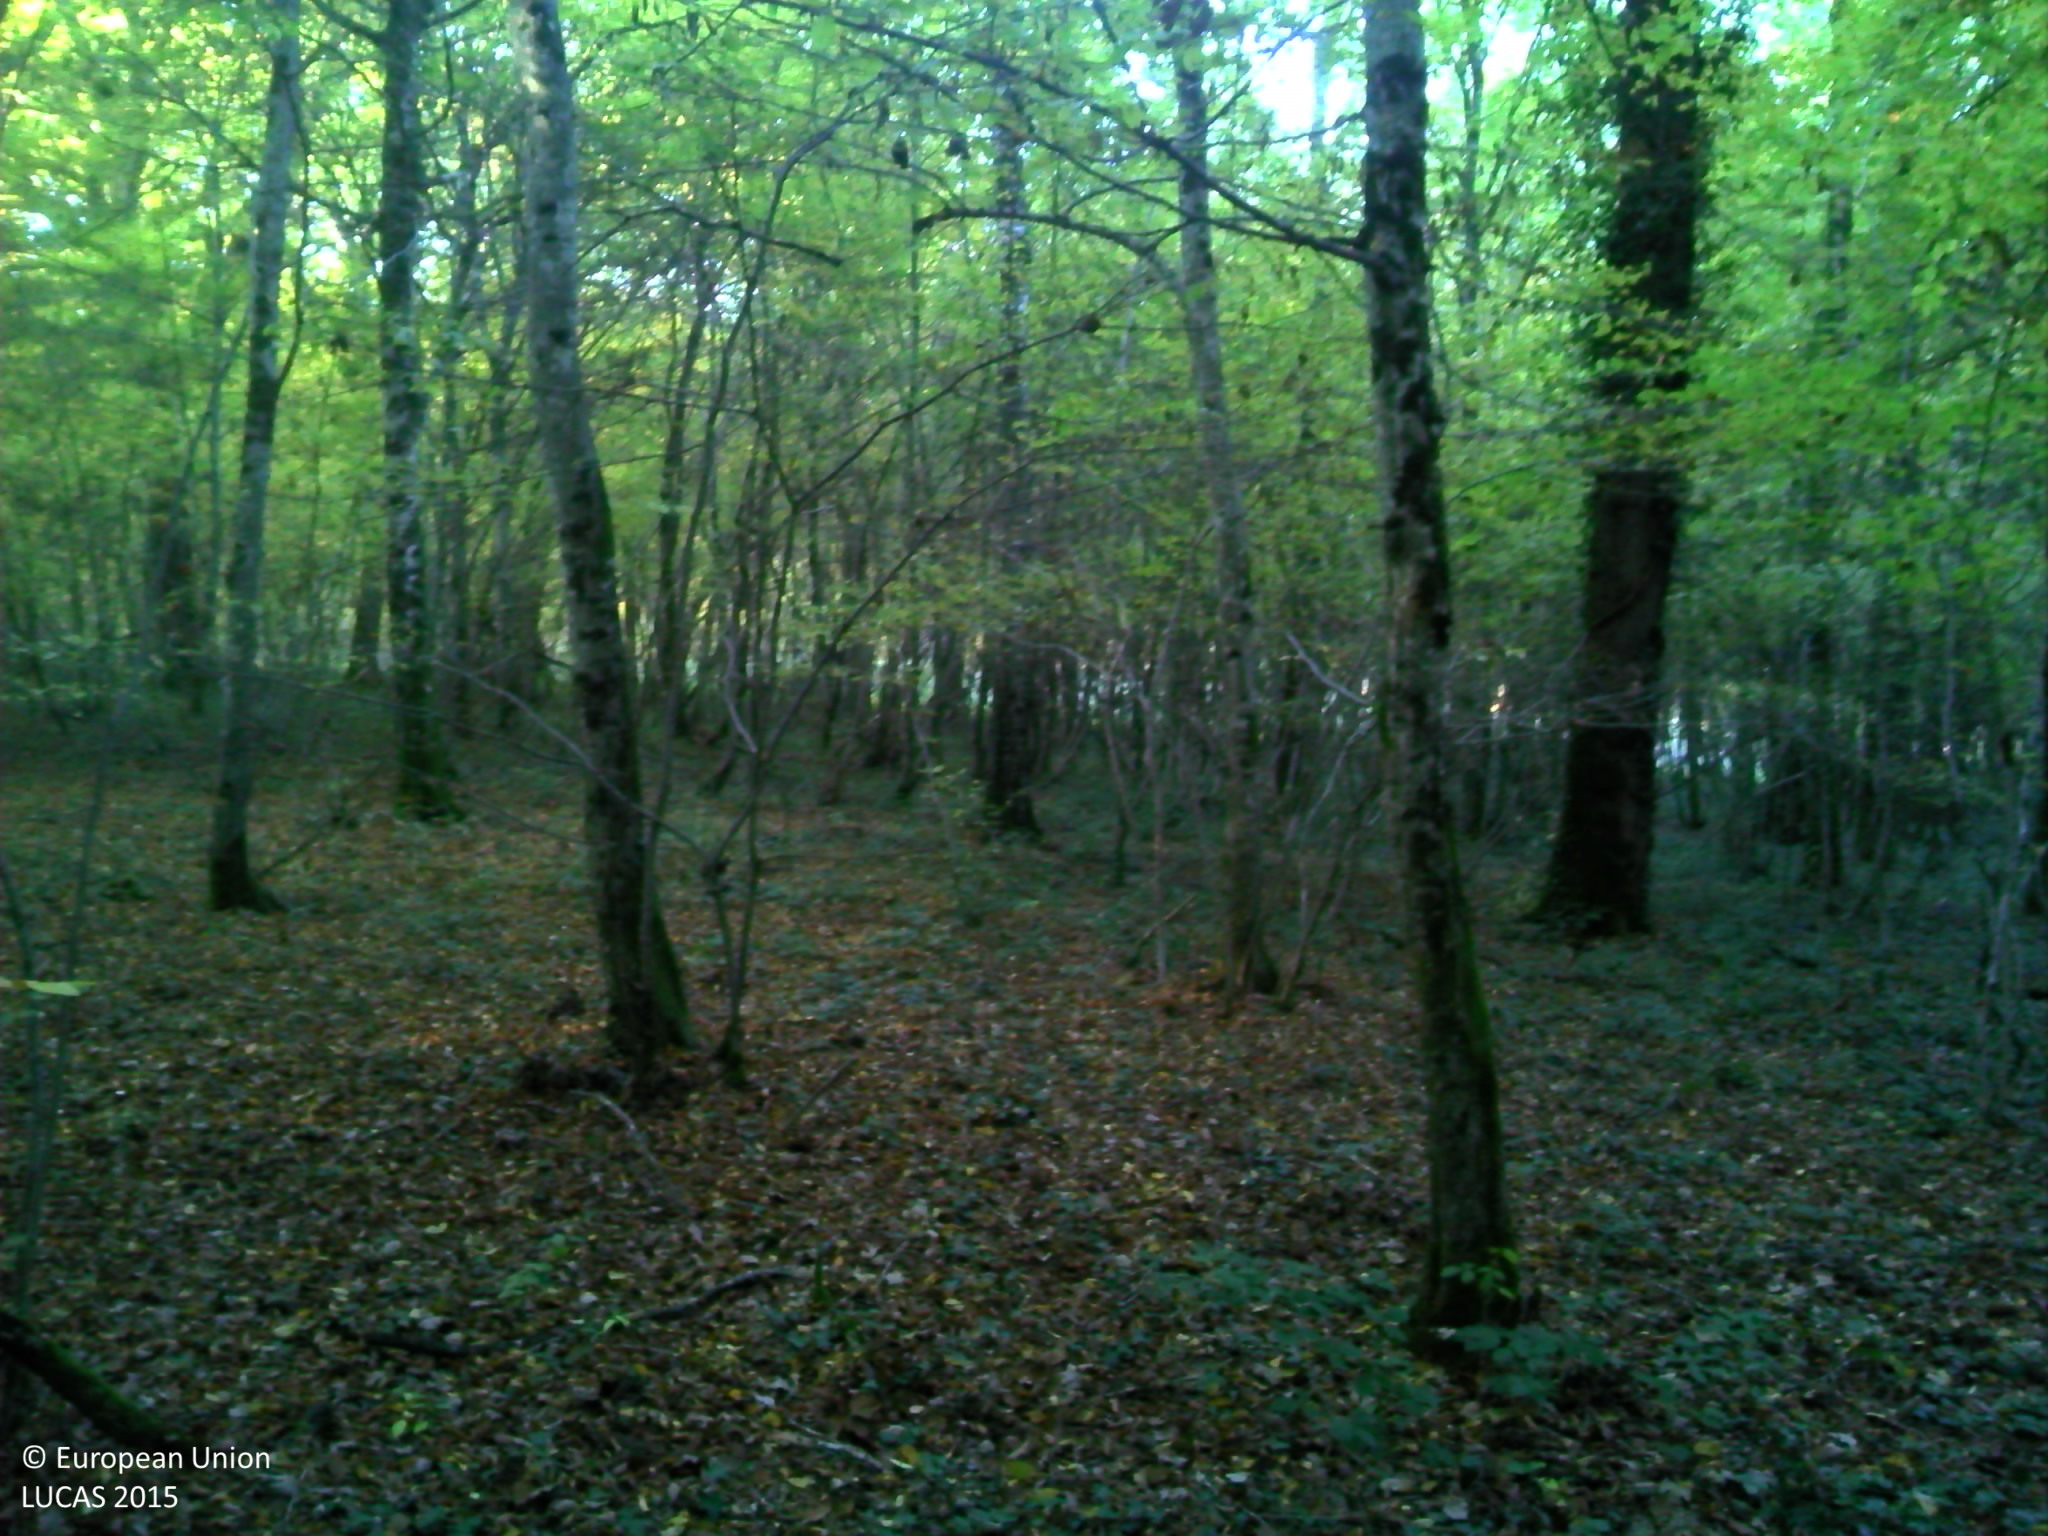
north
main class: Woodland
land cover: Broadleaved woodland
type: mesophytic deciduous forest
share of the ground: > 75 %
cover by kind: broadleaved forest trees 100 %
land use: Forestry
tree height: > 5 m
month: October
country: FR
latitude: 47.2416
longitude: 5.3377
